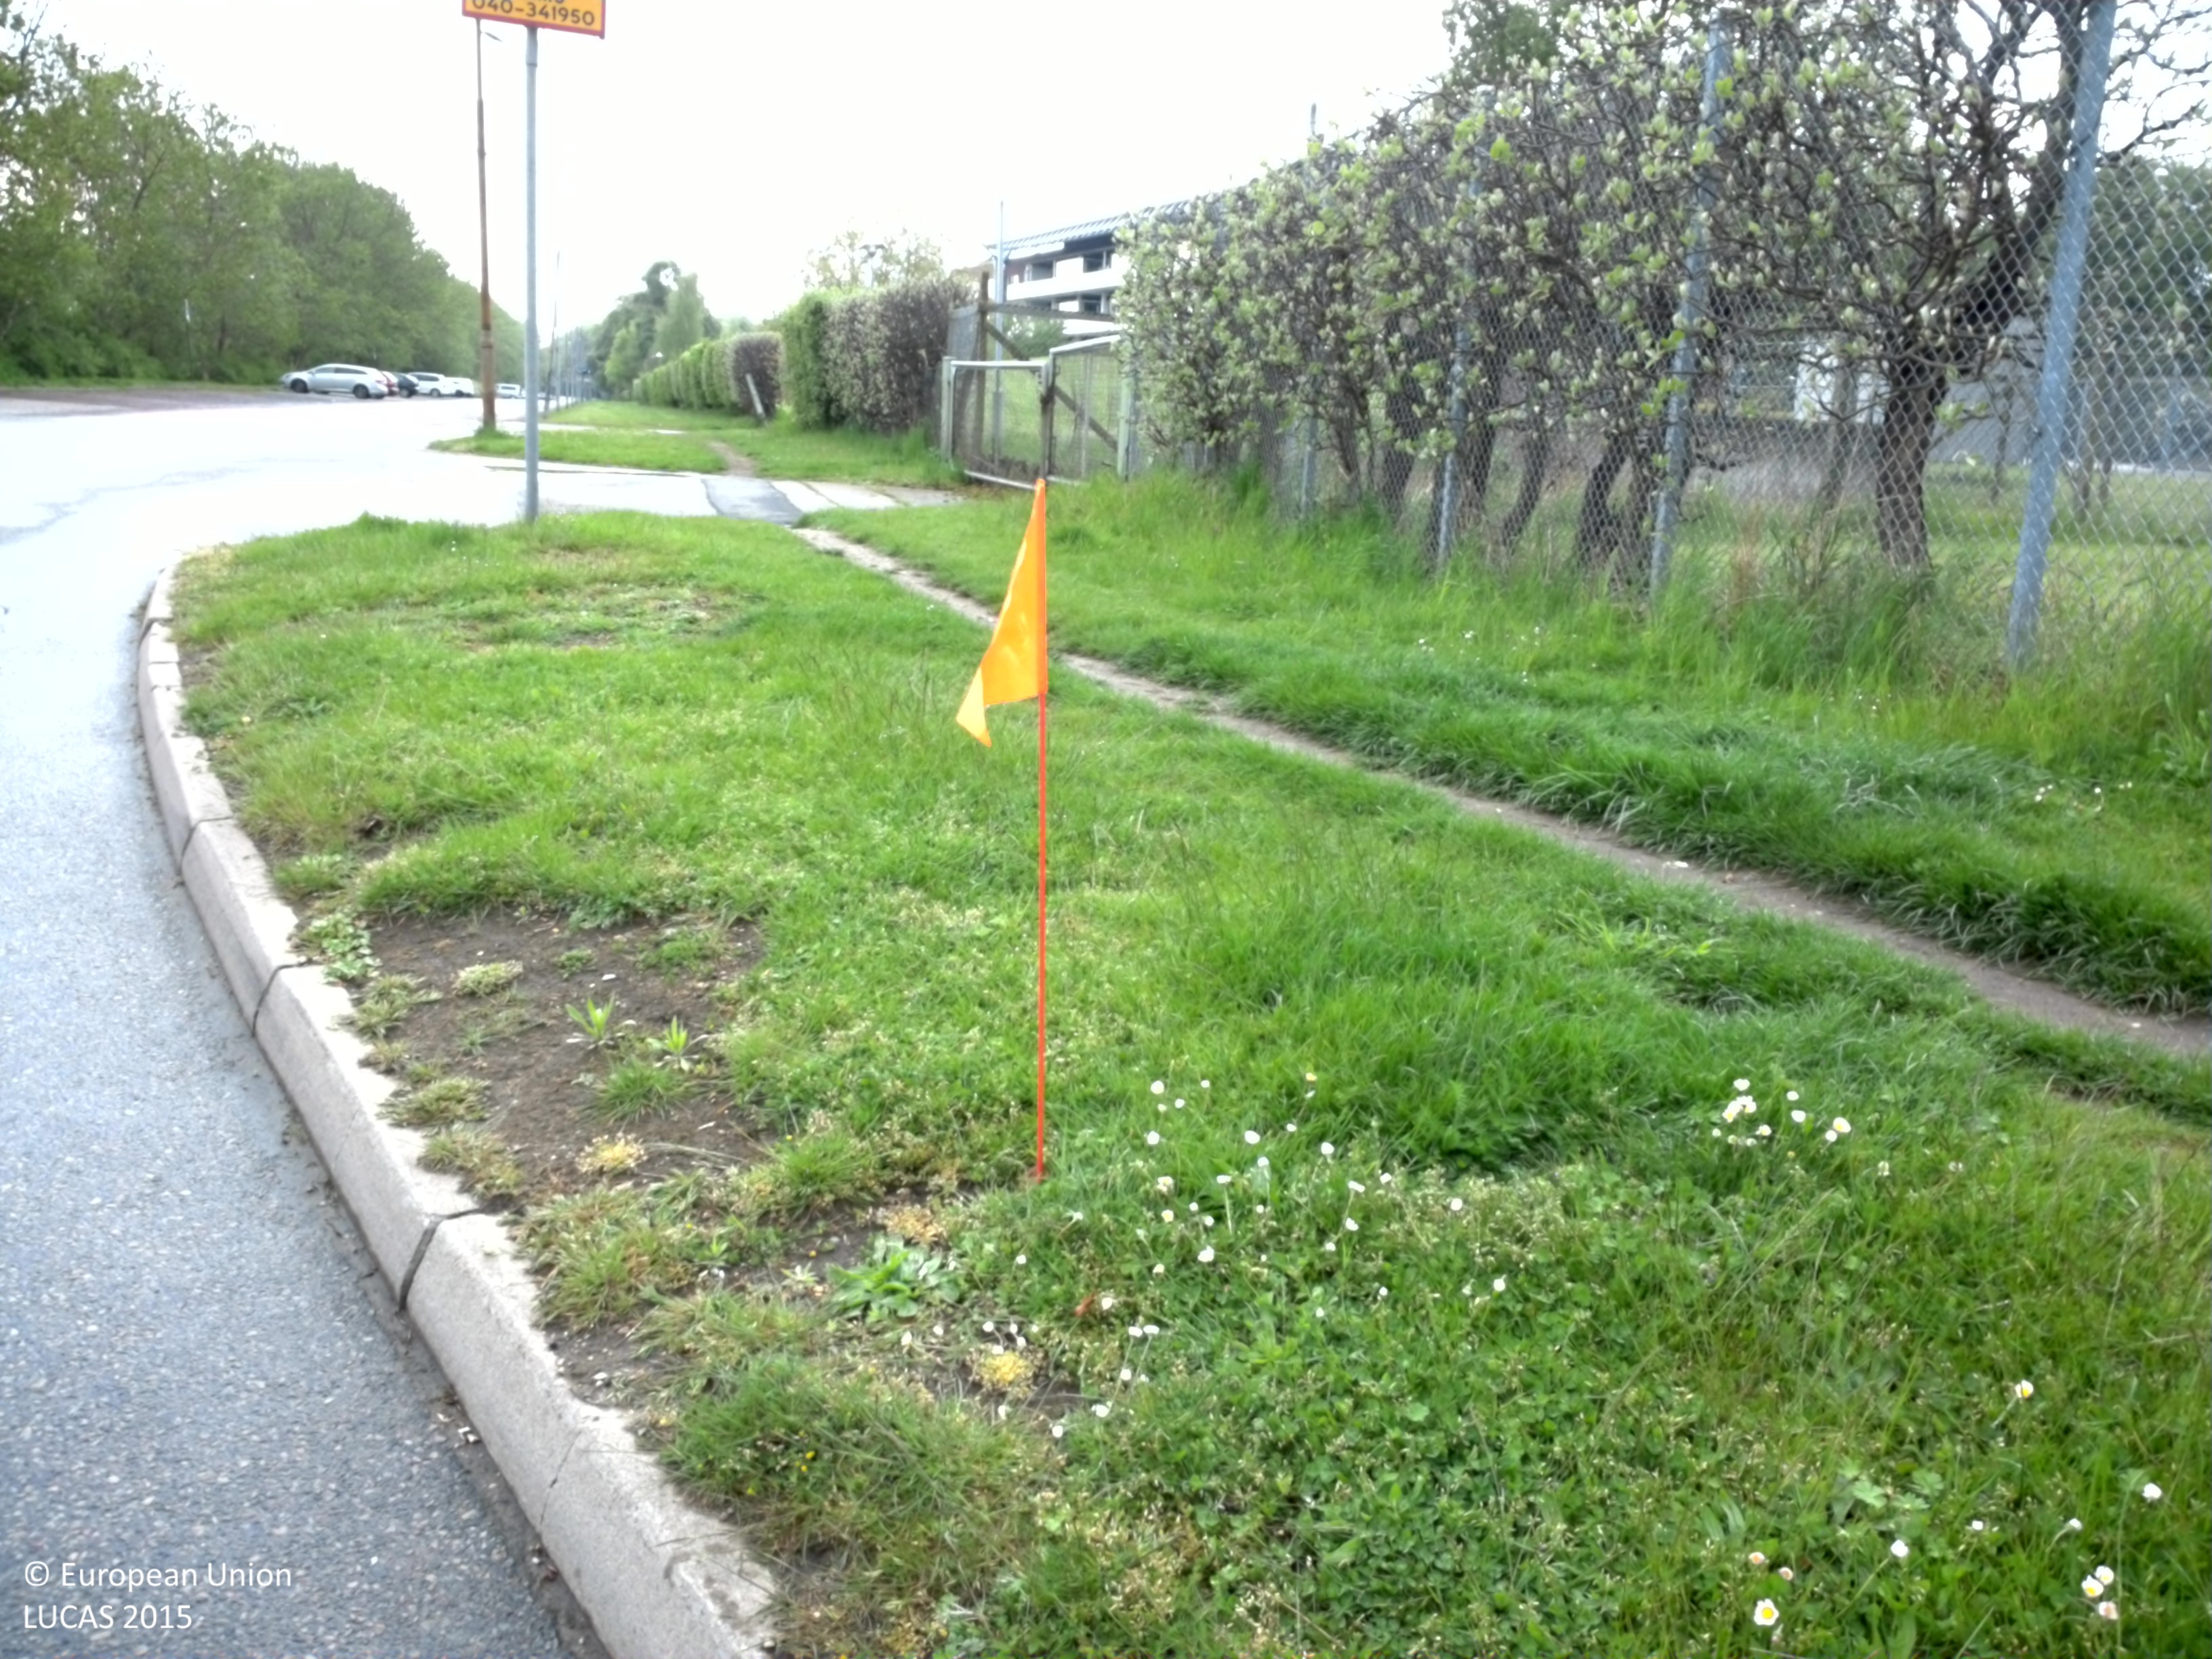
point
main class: Grassland
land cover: Grassland without tree/shrub cover
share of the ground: > 75 %
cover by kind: herbaceous plants 100 %
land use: Road transport
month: May
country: SE
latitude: 55.6116
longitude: 13.0620
